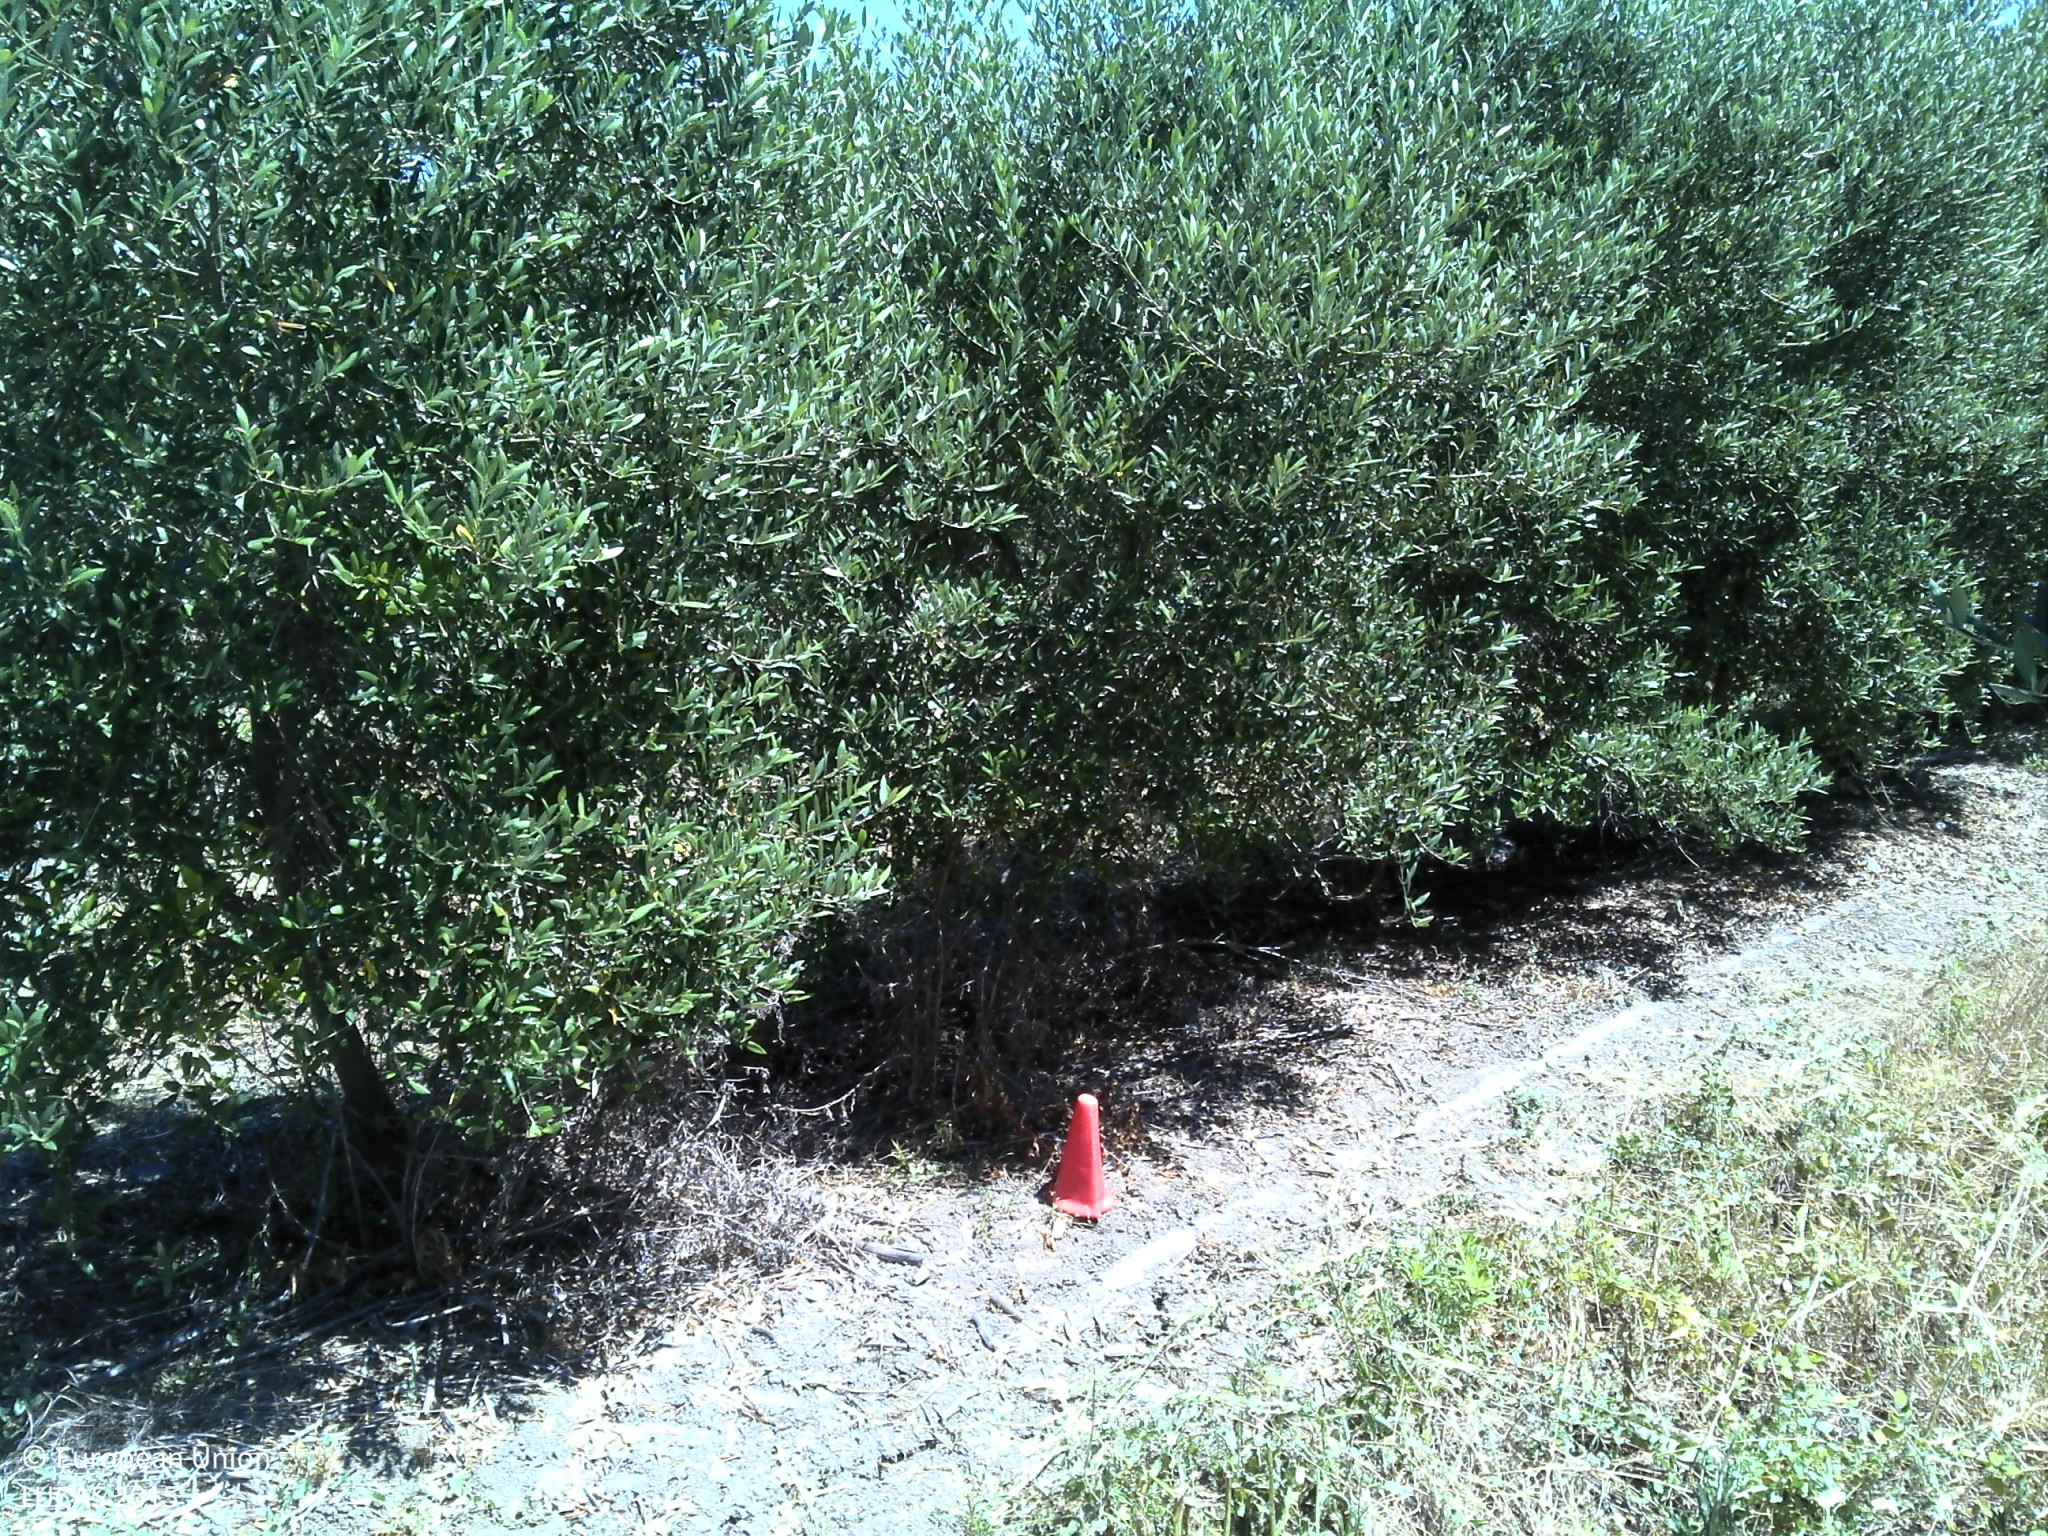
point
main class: Cropland
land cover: Olive groves
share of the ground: 50 - 75 %
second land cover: Grassland without tree/shrub cover
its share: 25 - 50 %
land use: Agriculture (excluding fallow land and kitchen gardens)
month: June
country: PT
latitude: 37.9538
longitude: -7.5341
